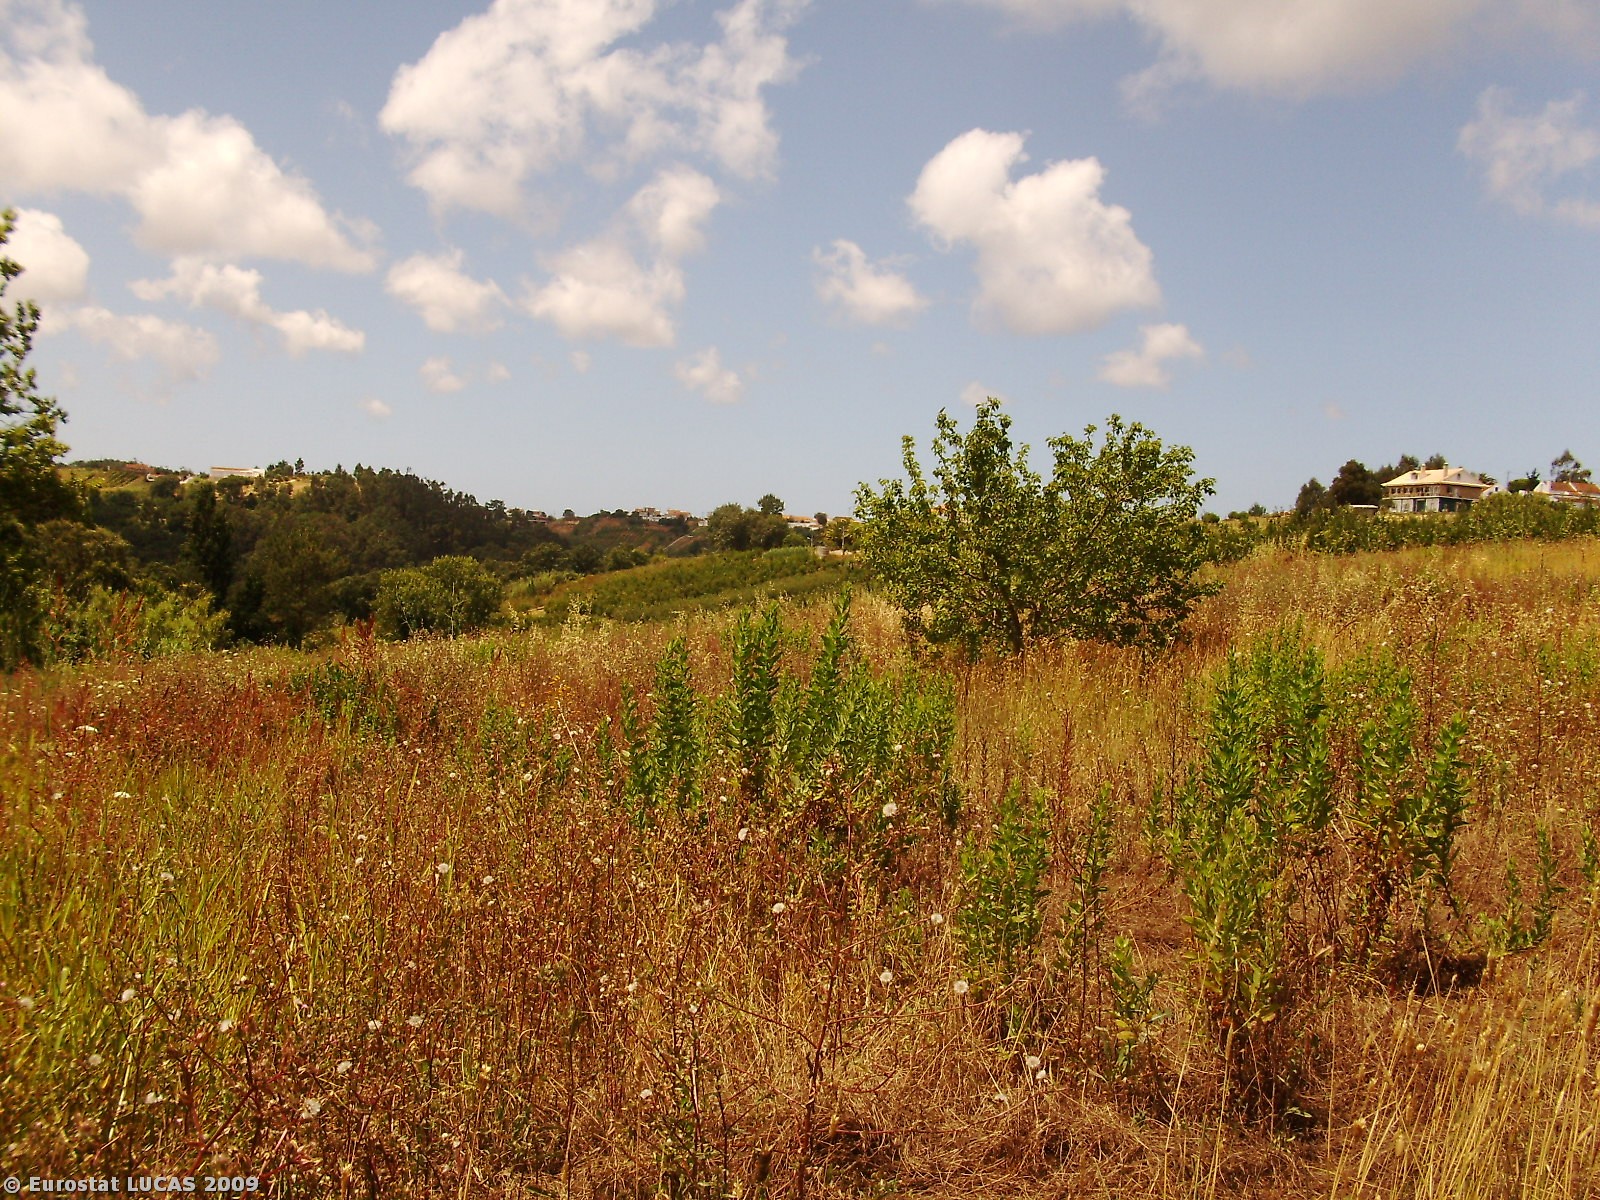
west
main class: Grassland
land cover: Spontaneously vegetated surfaces
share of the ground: > 75 %
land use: Fallow land
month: July
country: PT
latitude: 39.4702
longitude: -9.0702
